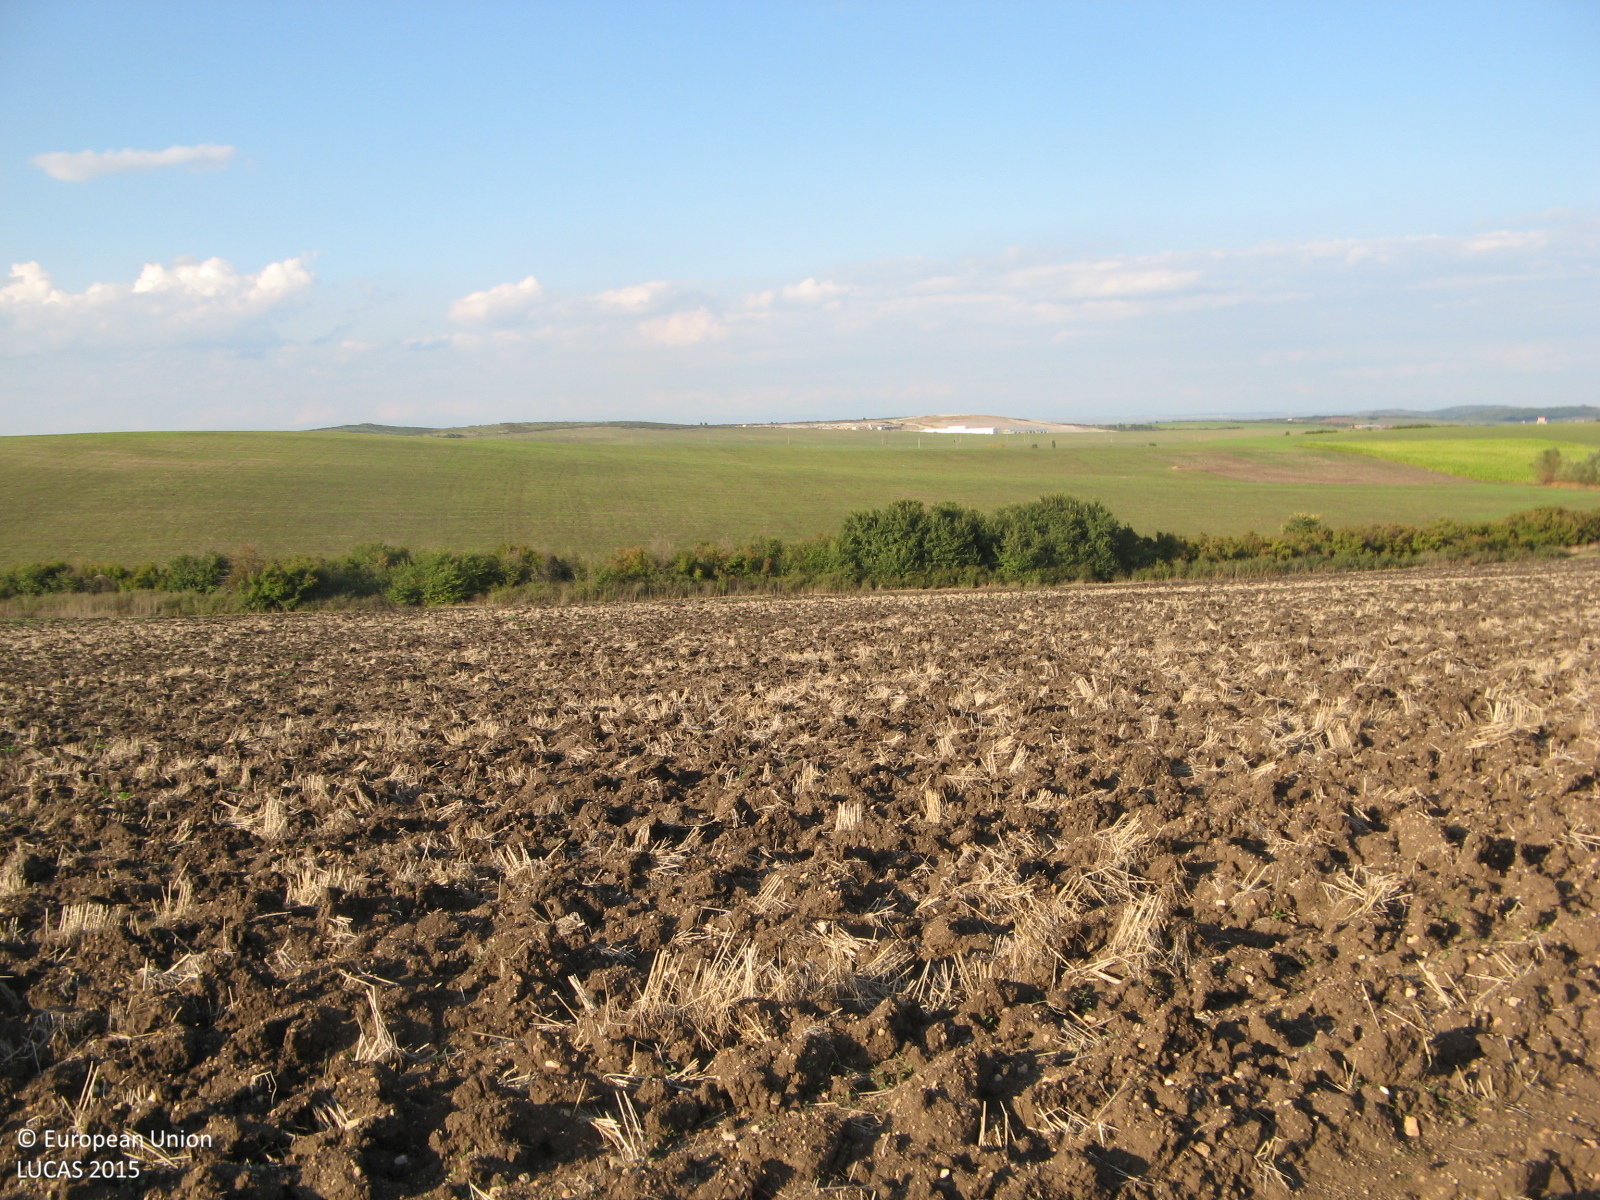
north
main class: Cropland
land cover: Common wheat
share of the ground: < 10 %
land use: Agriculture (excluding fallow land and kitchen gardens)
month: October
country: BG
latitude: 41.9214
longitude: 25.4356
